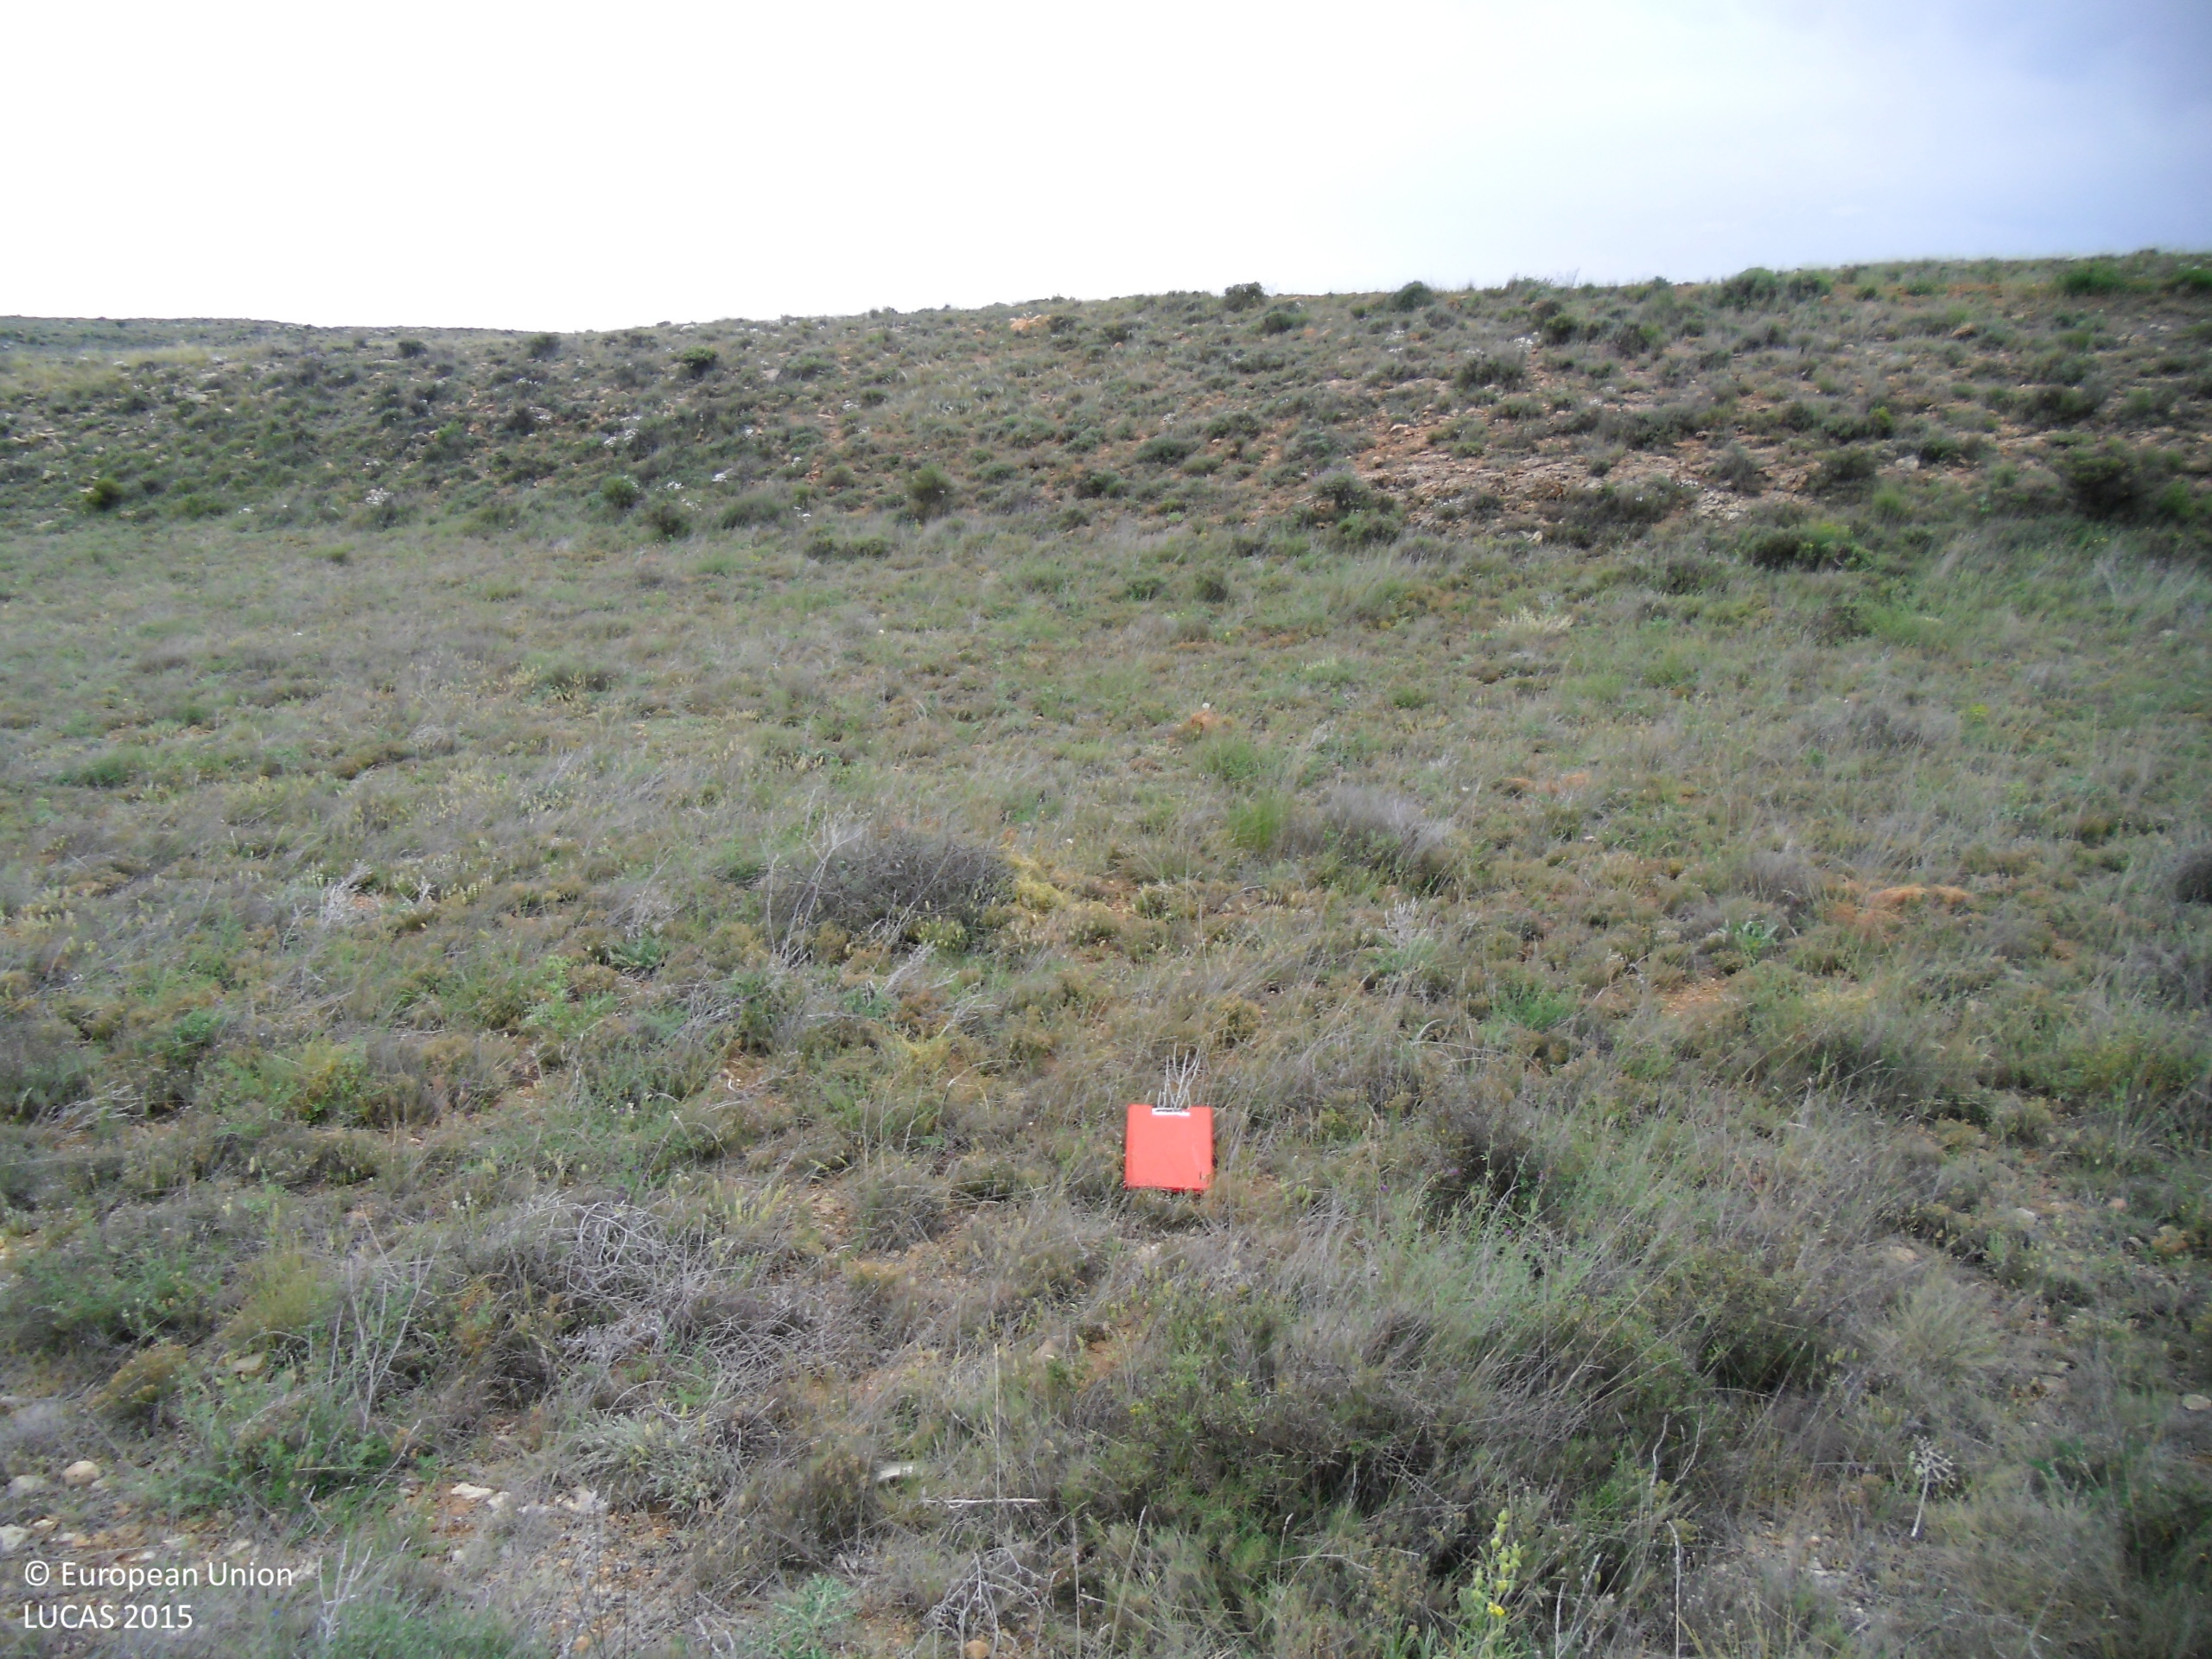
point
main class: Shrubland
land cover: Shrubland without tree cover
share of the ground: 50 - 75 %
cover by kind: shrubs 60 %, herbaceous plants 20 %, unconsolidated bare surface 20 %
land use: Agriculture (excluding fallow land and kitchen gardens)
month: May
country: ES
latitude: 41.0106
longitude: -0.8716
